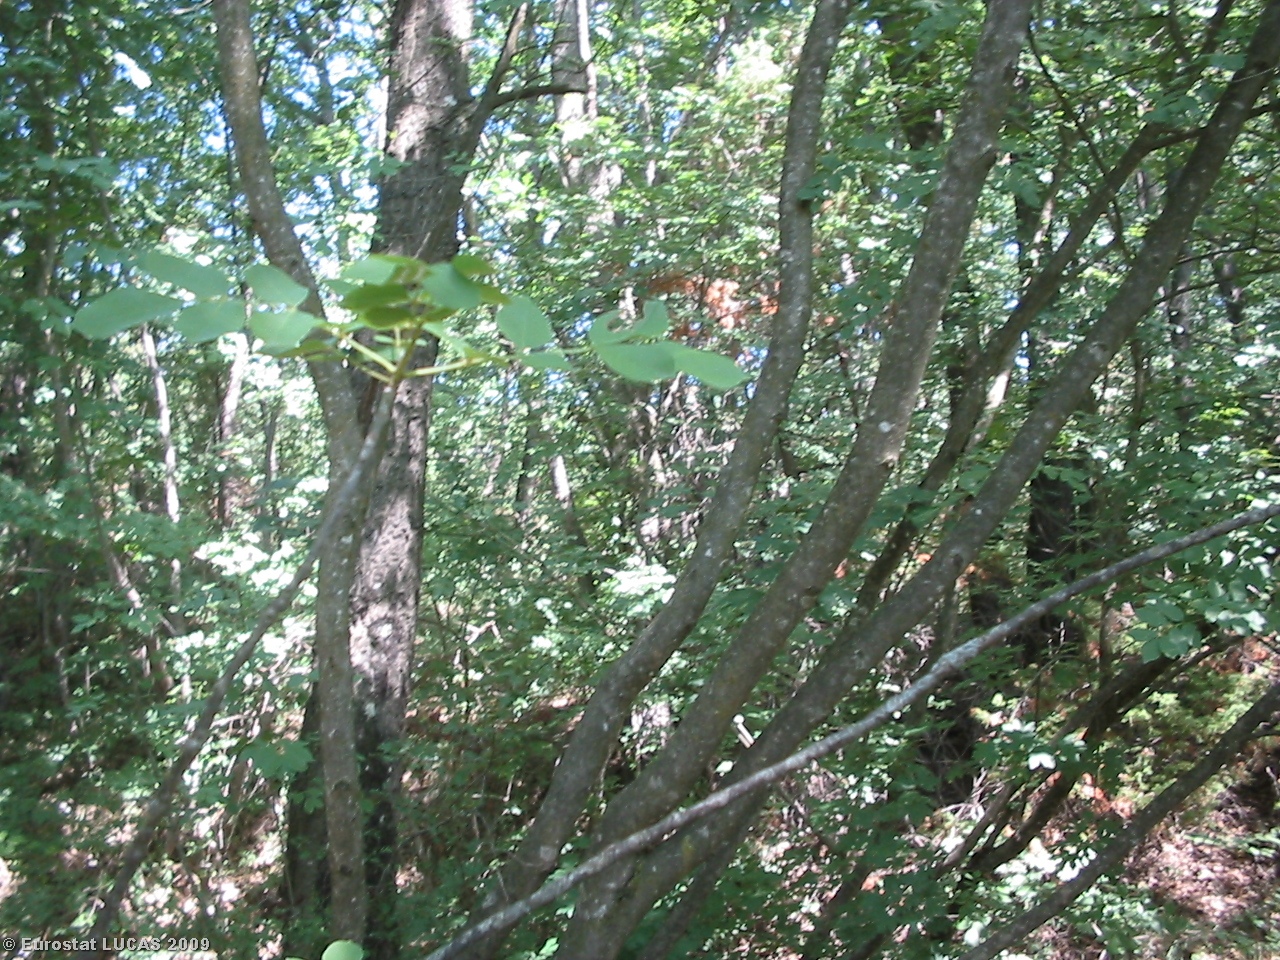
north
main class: Woodland
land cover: Broadleaved woodland
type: thermophilous deciduous forest
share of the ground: > 75 %
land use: Forestry
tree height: > 5 m
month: August
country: IT
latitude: 44.4405
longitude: 10.2382
